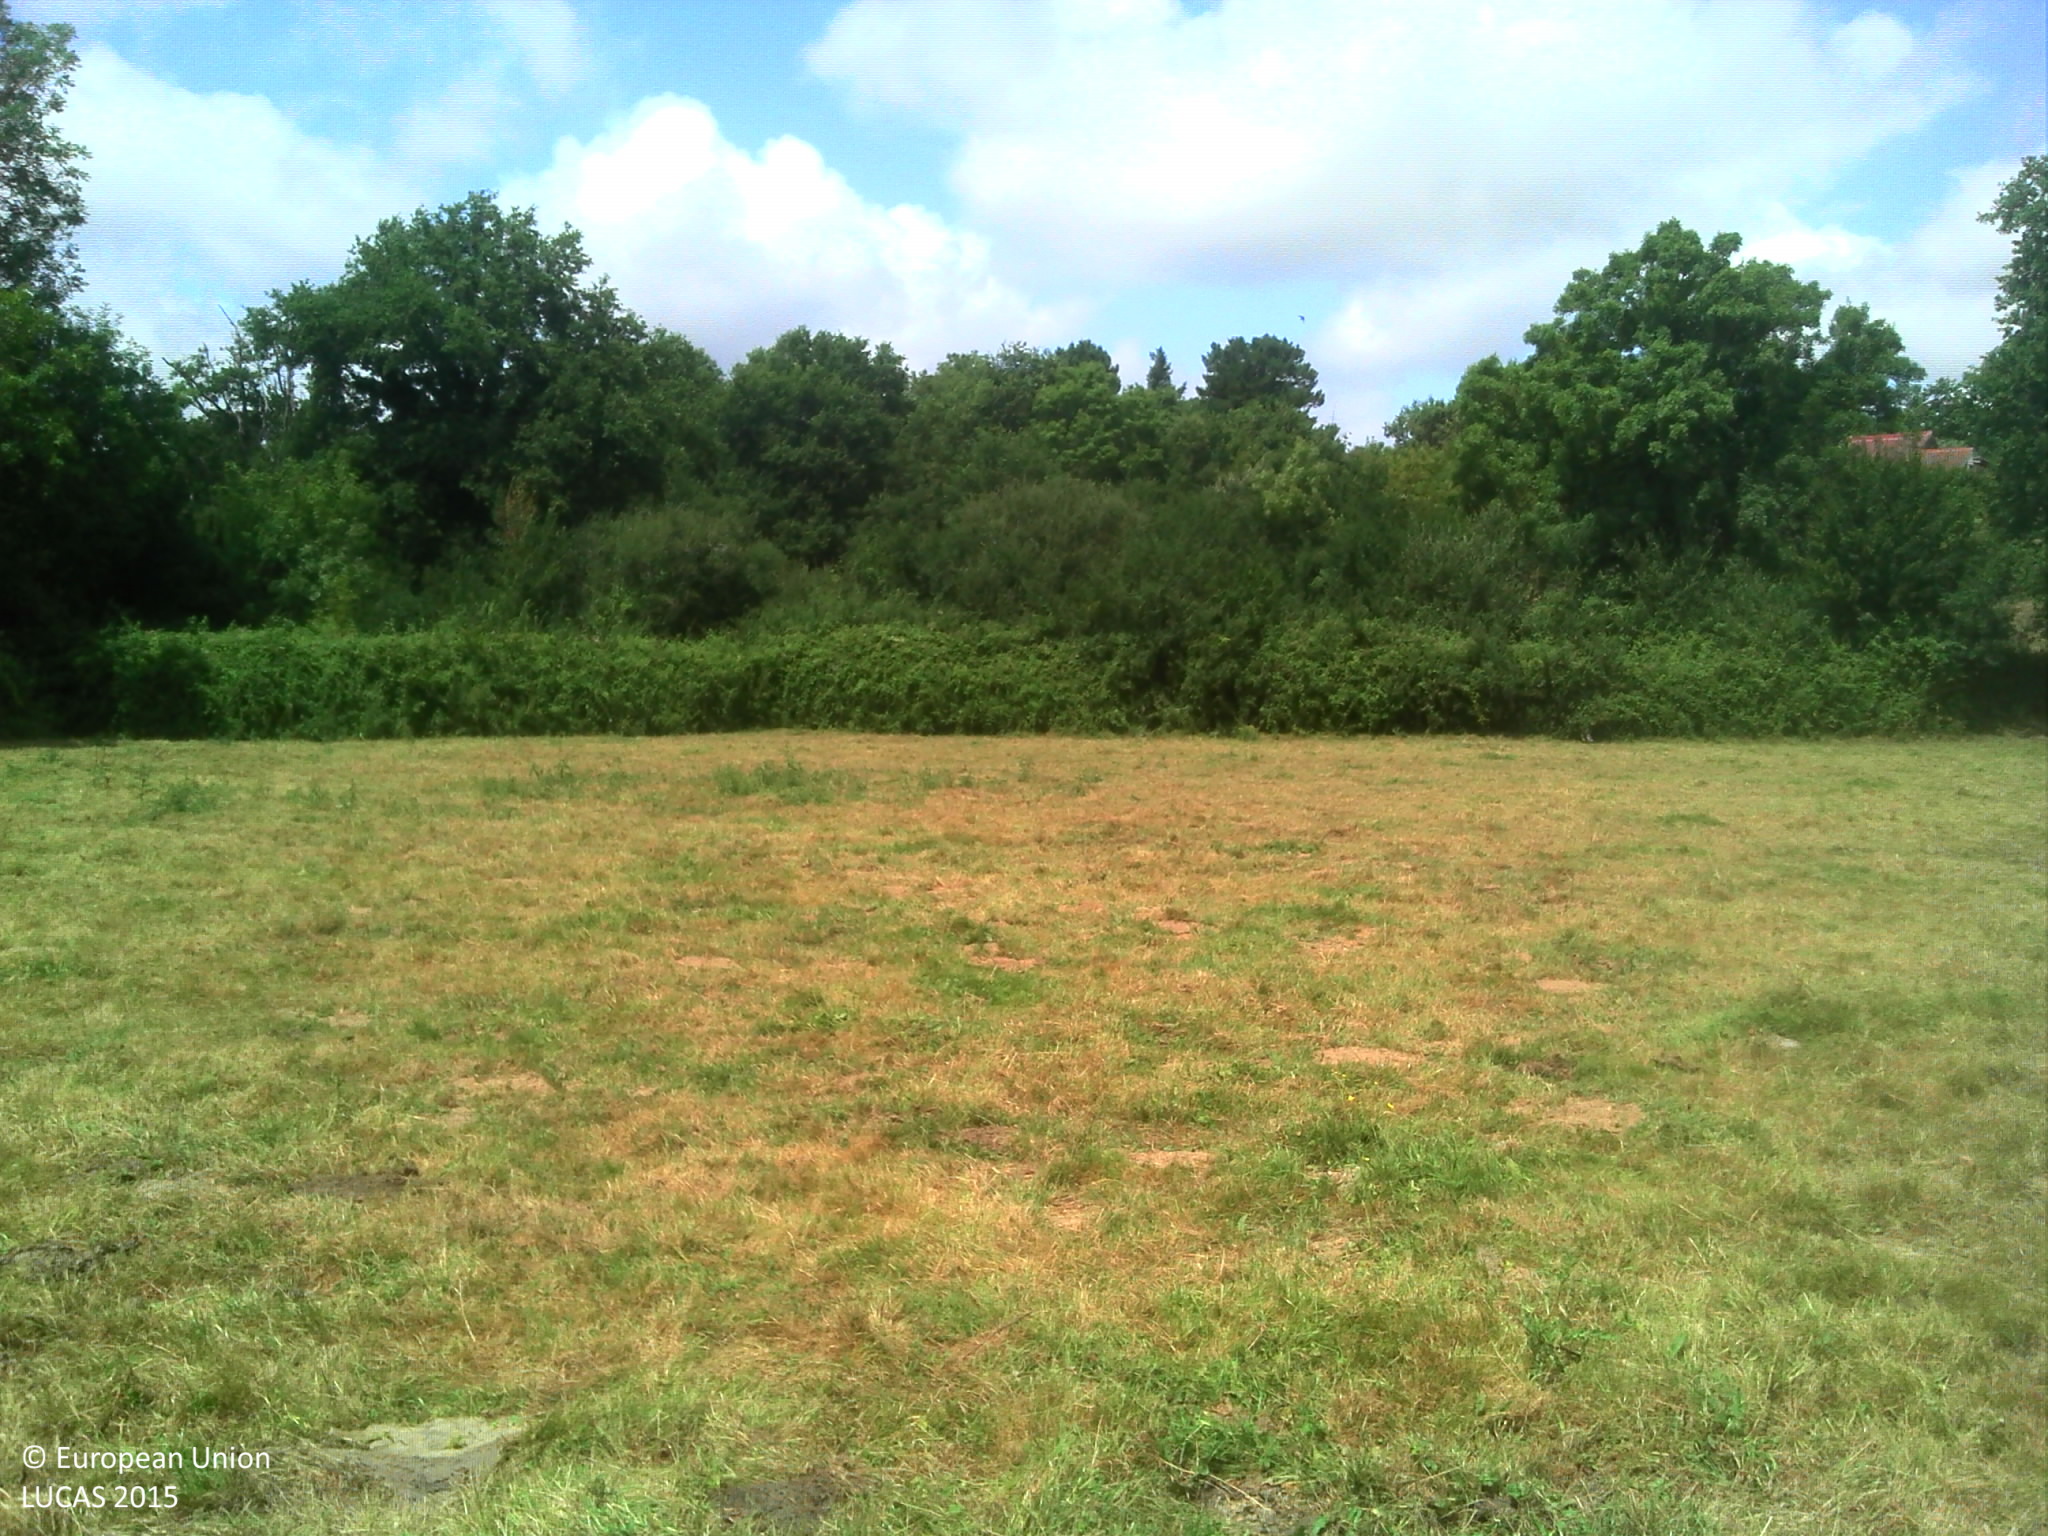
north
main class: Grassland
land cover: Grassland without tree/shrub cover
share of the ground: > 75 %
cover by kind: herbaceous plants 100 %
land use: Agriculture (excluding fallow land and kitchen gardens)
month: July
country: FR
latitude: 46.5074
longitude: -1.3609
